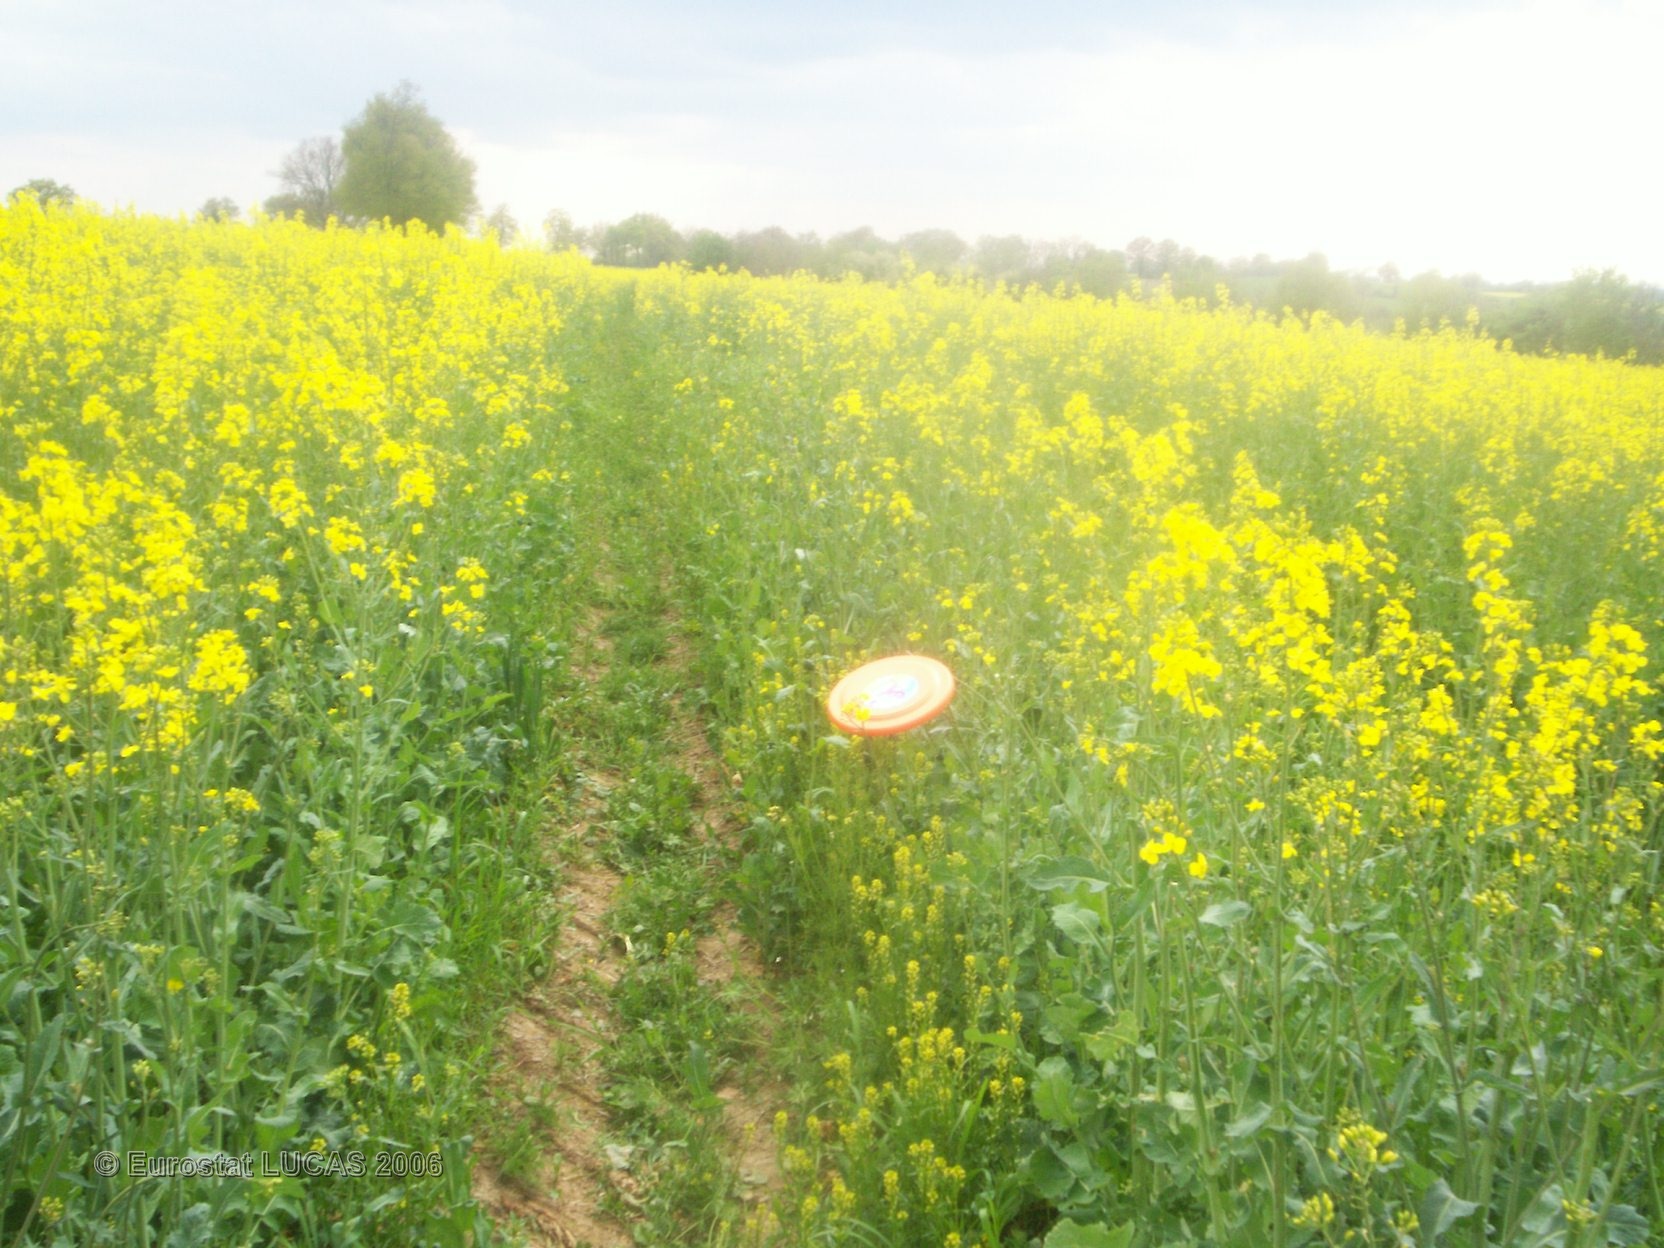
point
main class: Cropland
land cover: Rape and turnip rape
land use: Agriculture (excluding fallow land and kitchen gardens)
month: May
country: FR
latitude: 46.4705
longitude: 3.0822
